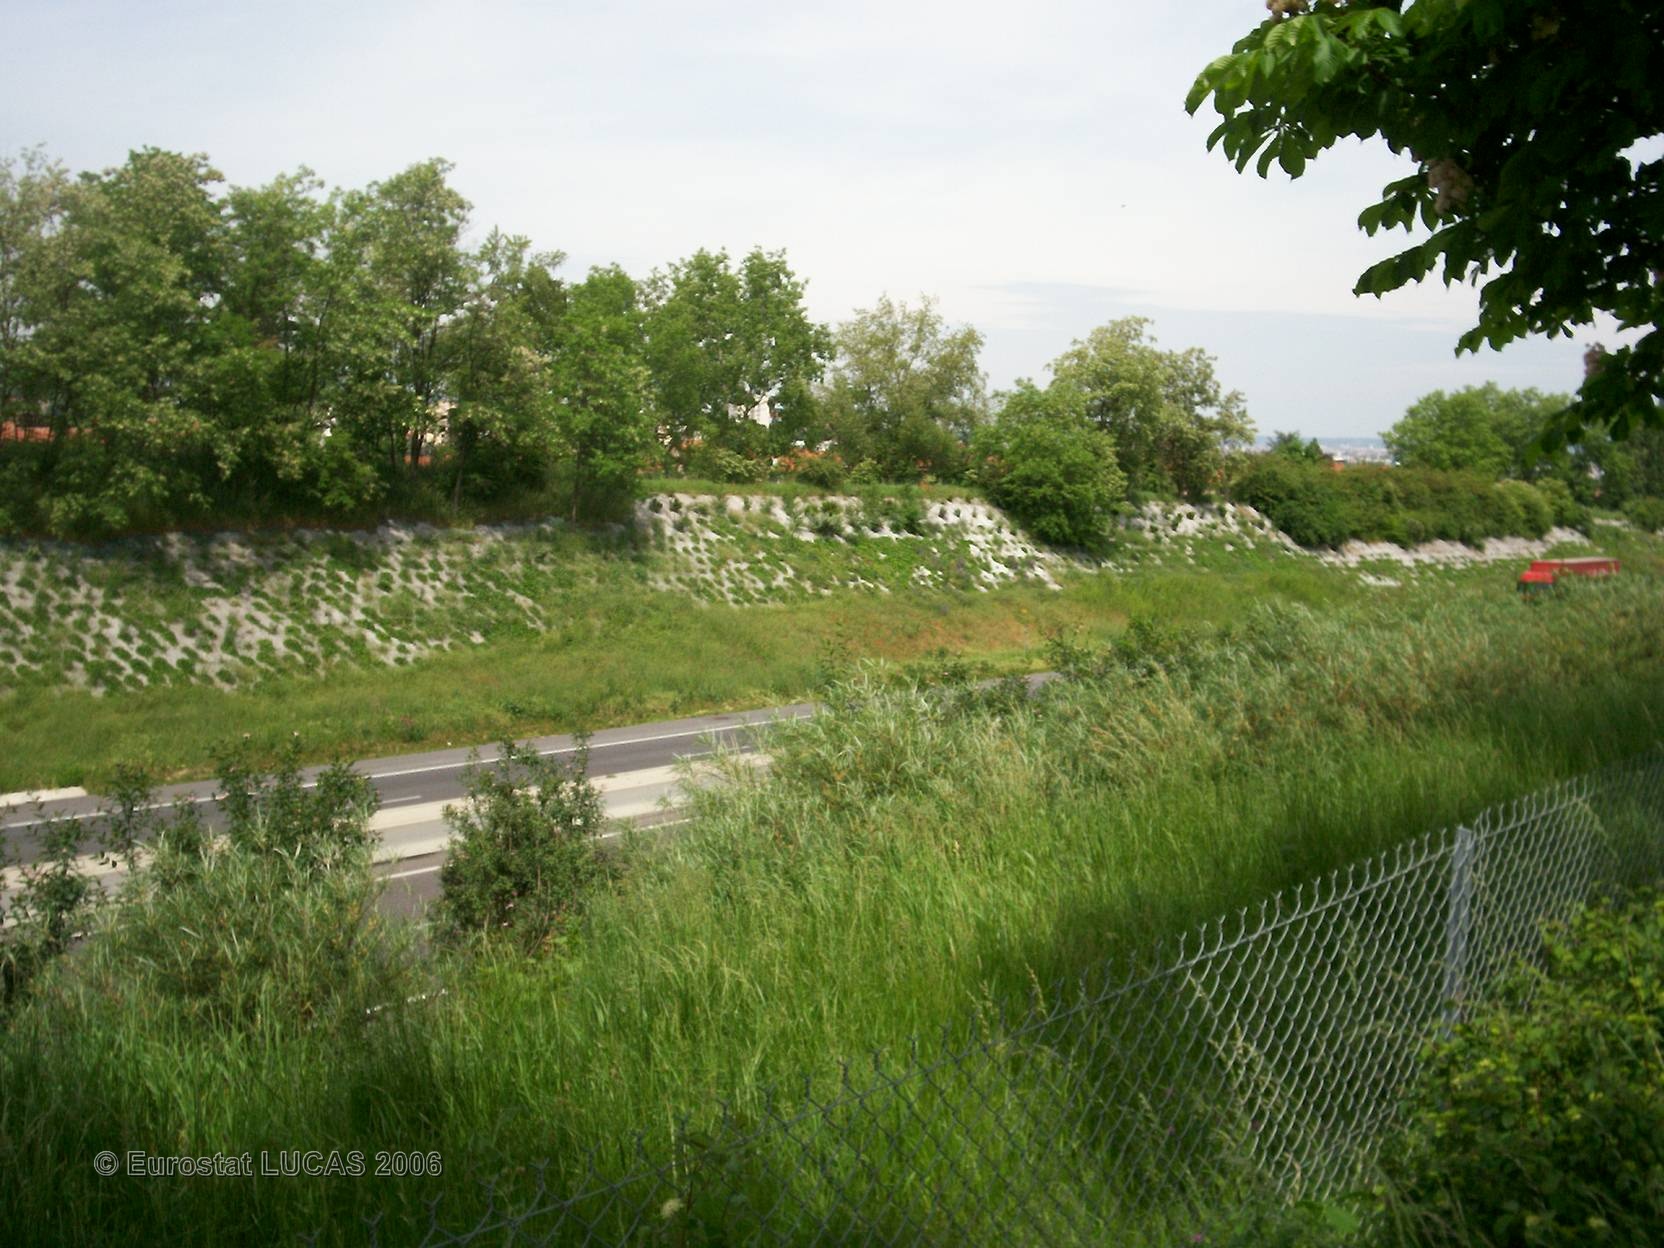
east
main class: Grassland
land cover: Grassland with sparse tree/shrub cover
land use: Unused
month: May
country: FR
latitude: 45.6834
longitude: 4.8038
